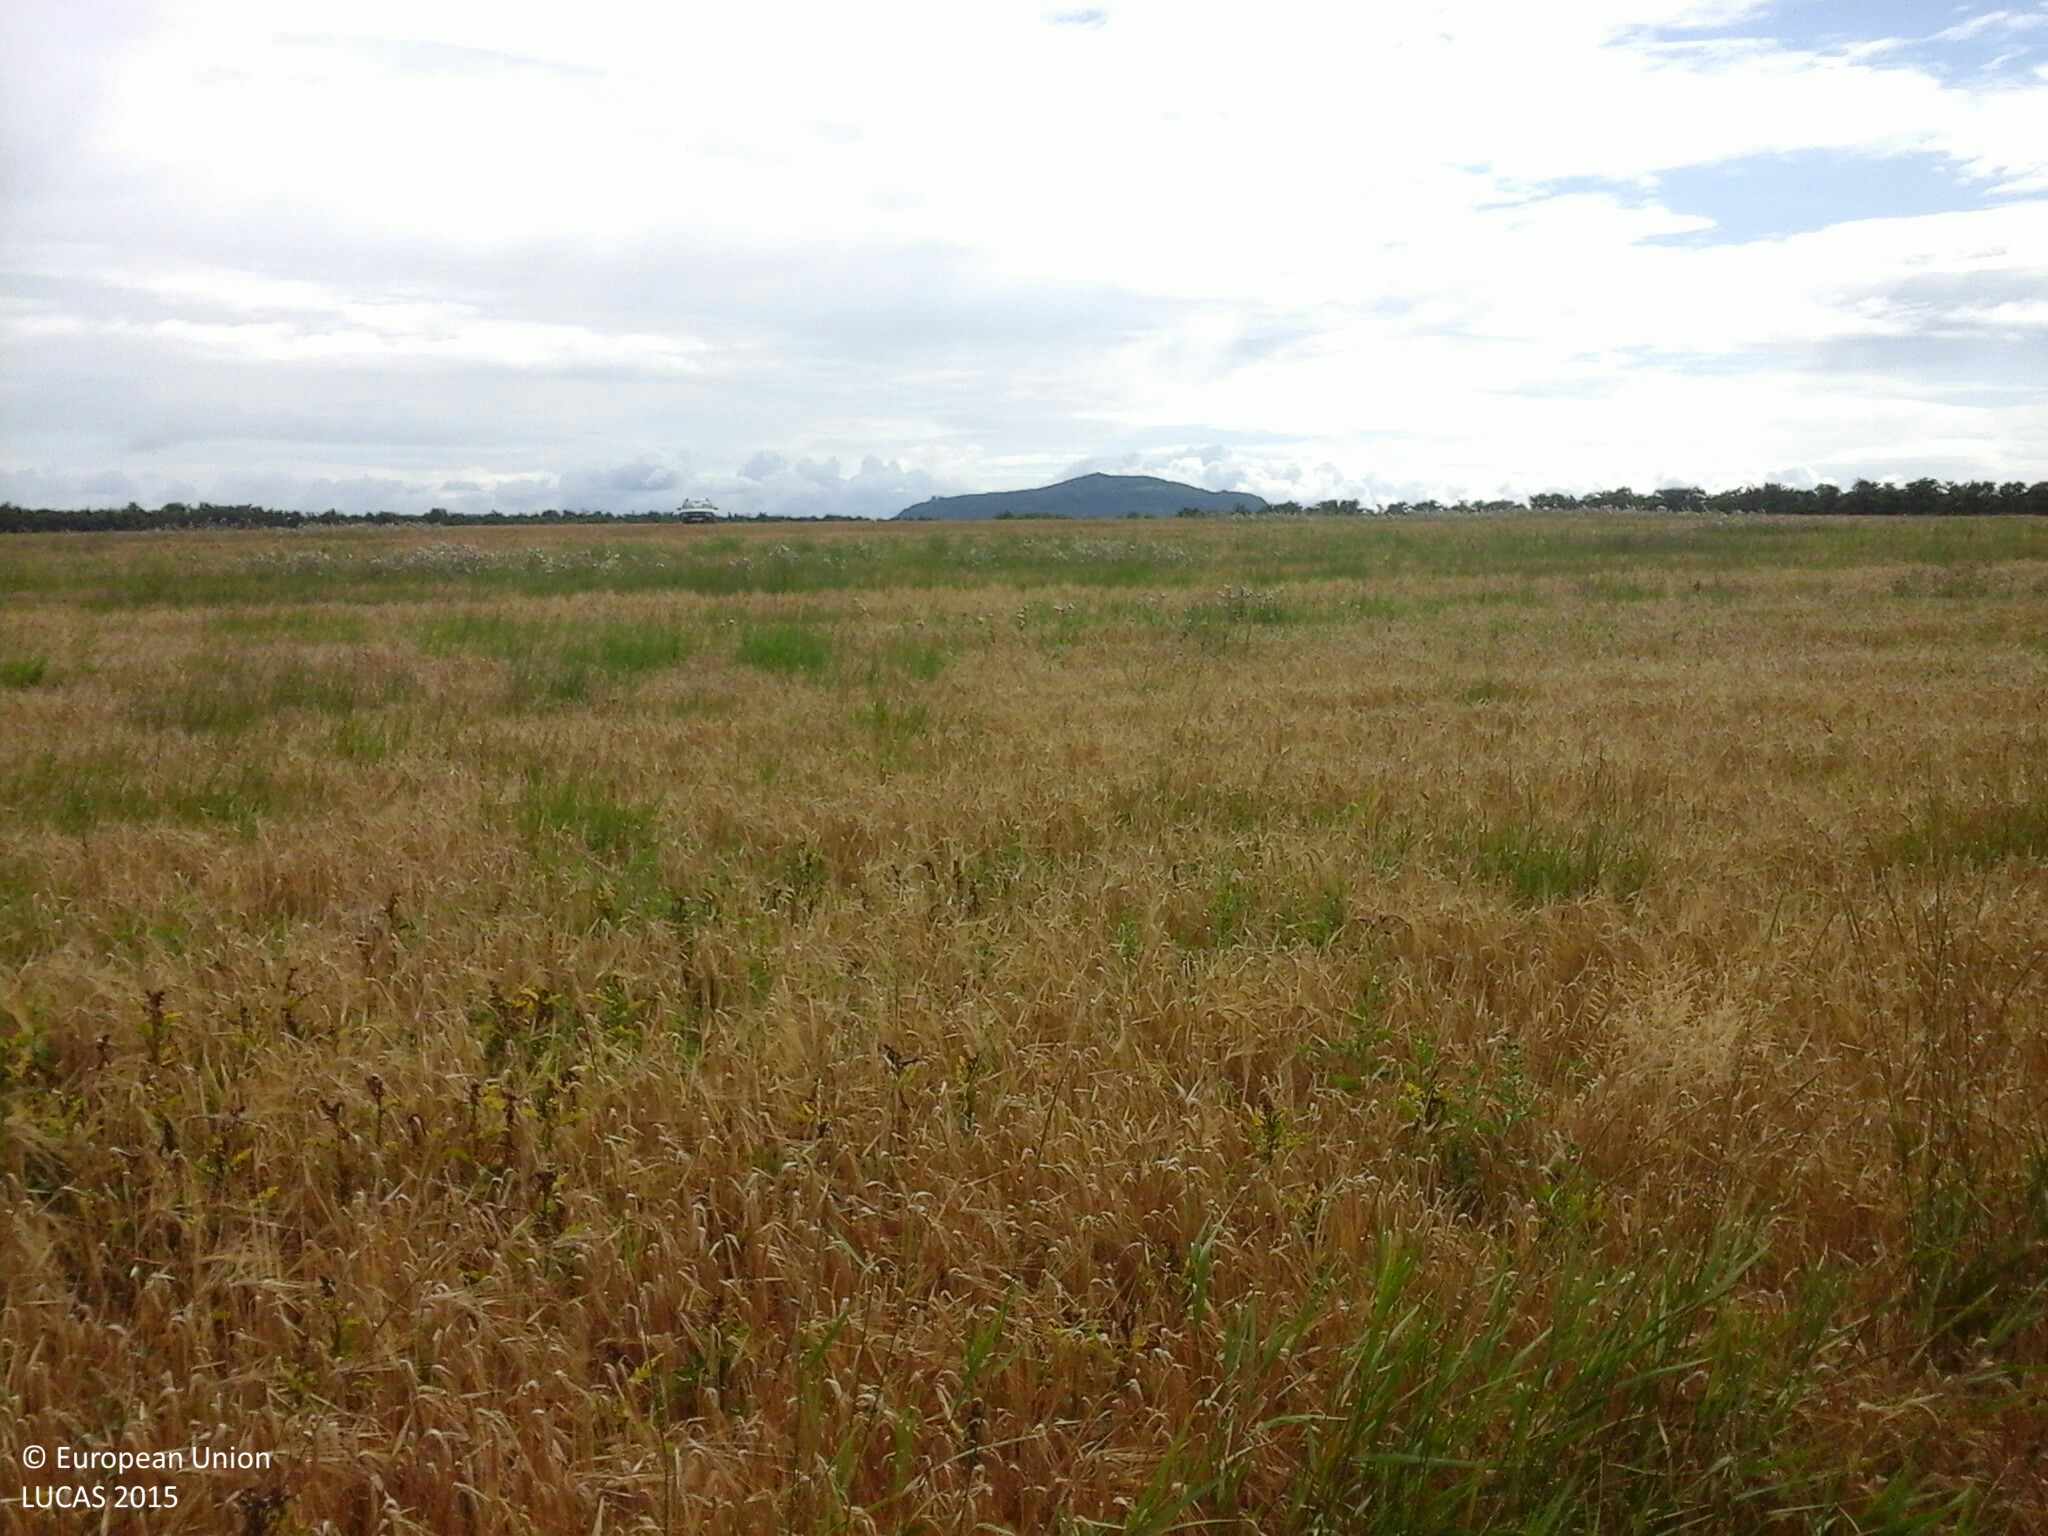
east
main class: Cropland
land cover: Barley
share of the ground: > 75 %
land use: Agriculture (excluding fallow land and kitchen gardens)
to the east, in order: Barley; Common wheat
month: July
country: HU
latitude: 47.1502
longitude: 17.2991
